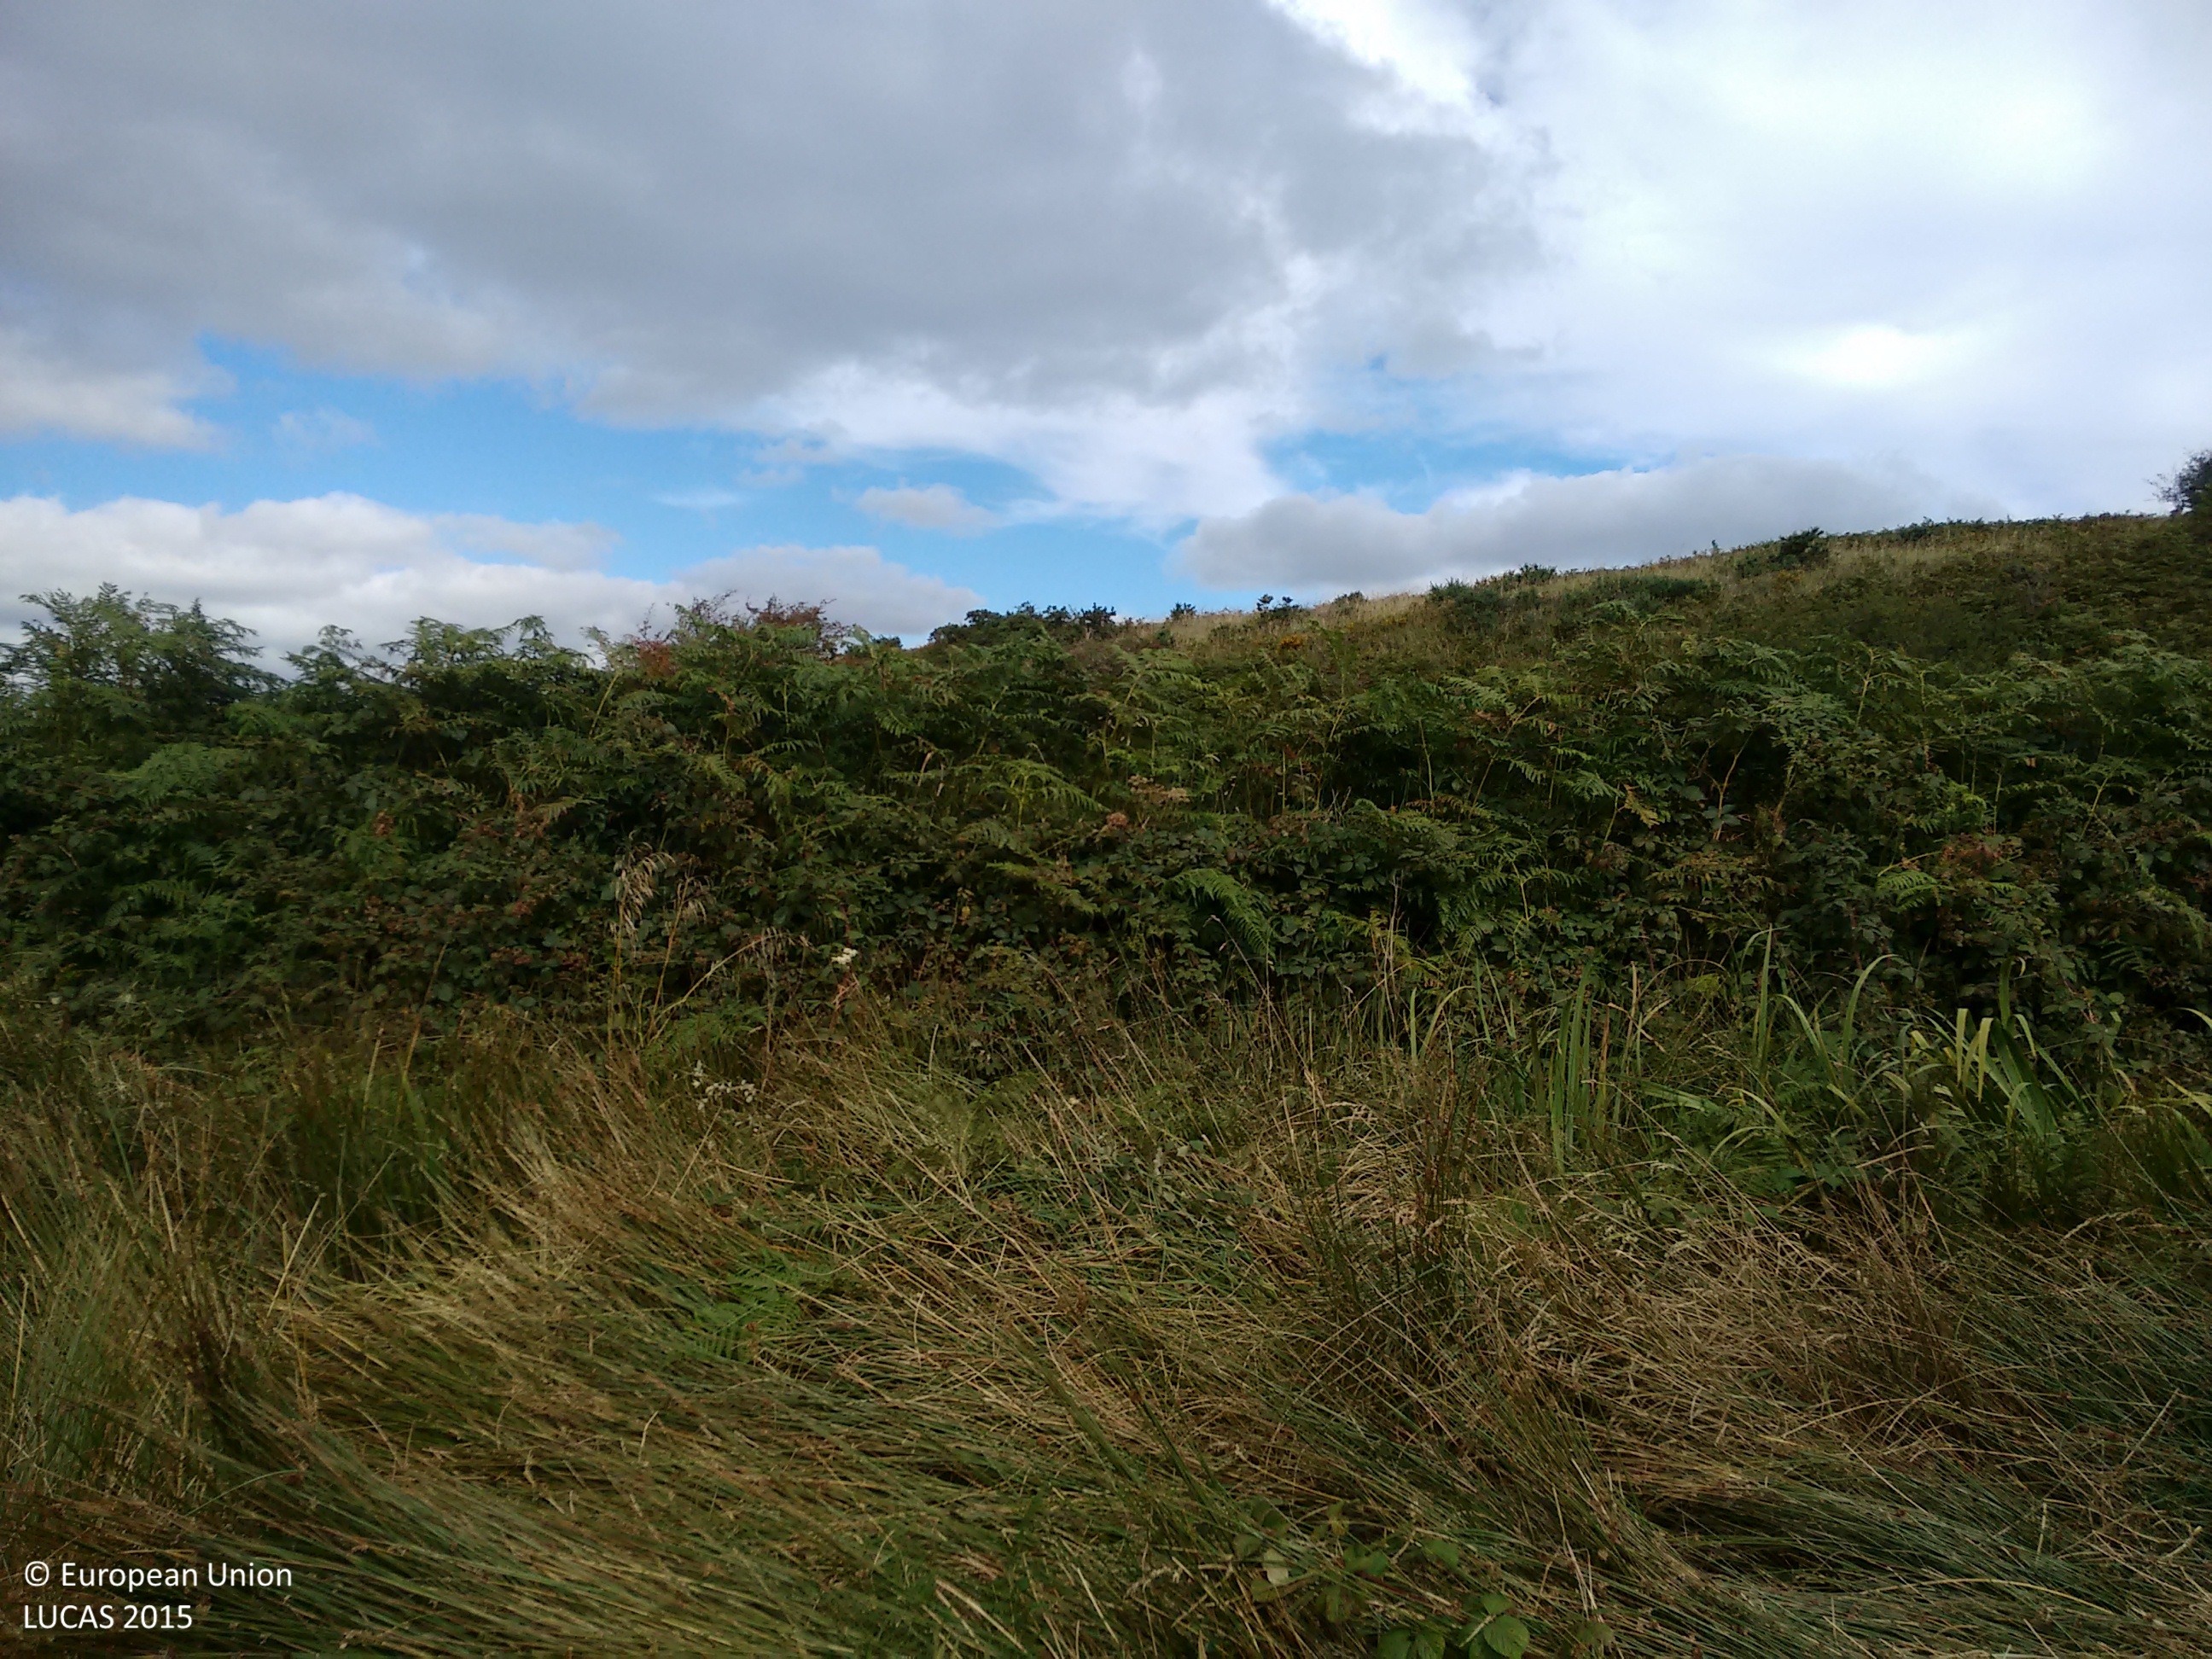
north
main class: Grassland
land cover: Grassland with sparse tree/shrub cover
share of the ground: > 75 %
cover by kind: herbaceous plants 90 %, broadleaved forest trees 5 %, shrubs 5 %
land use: Agriculture (excluding fallow land and kitchen gardens)
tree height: < 5 m
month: September
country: IE
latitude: 52.3914
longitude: -9.4669
